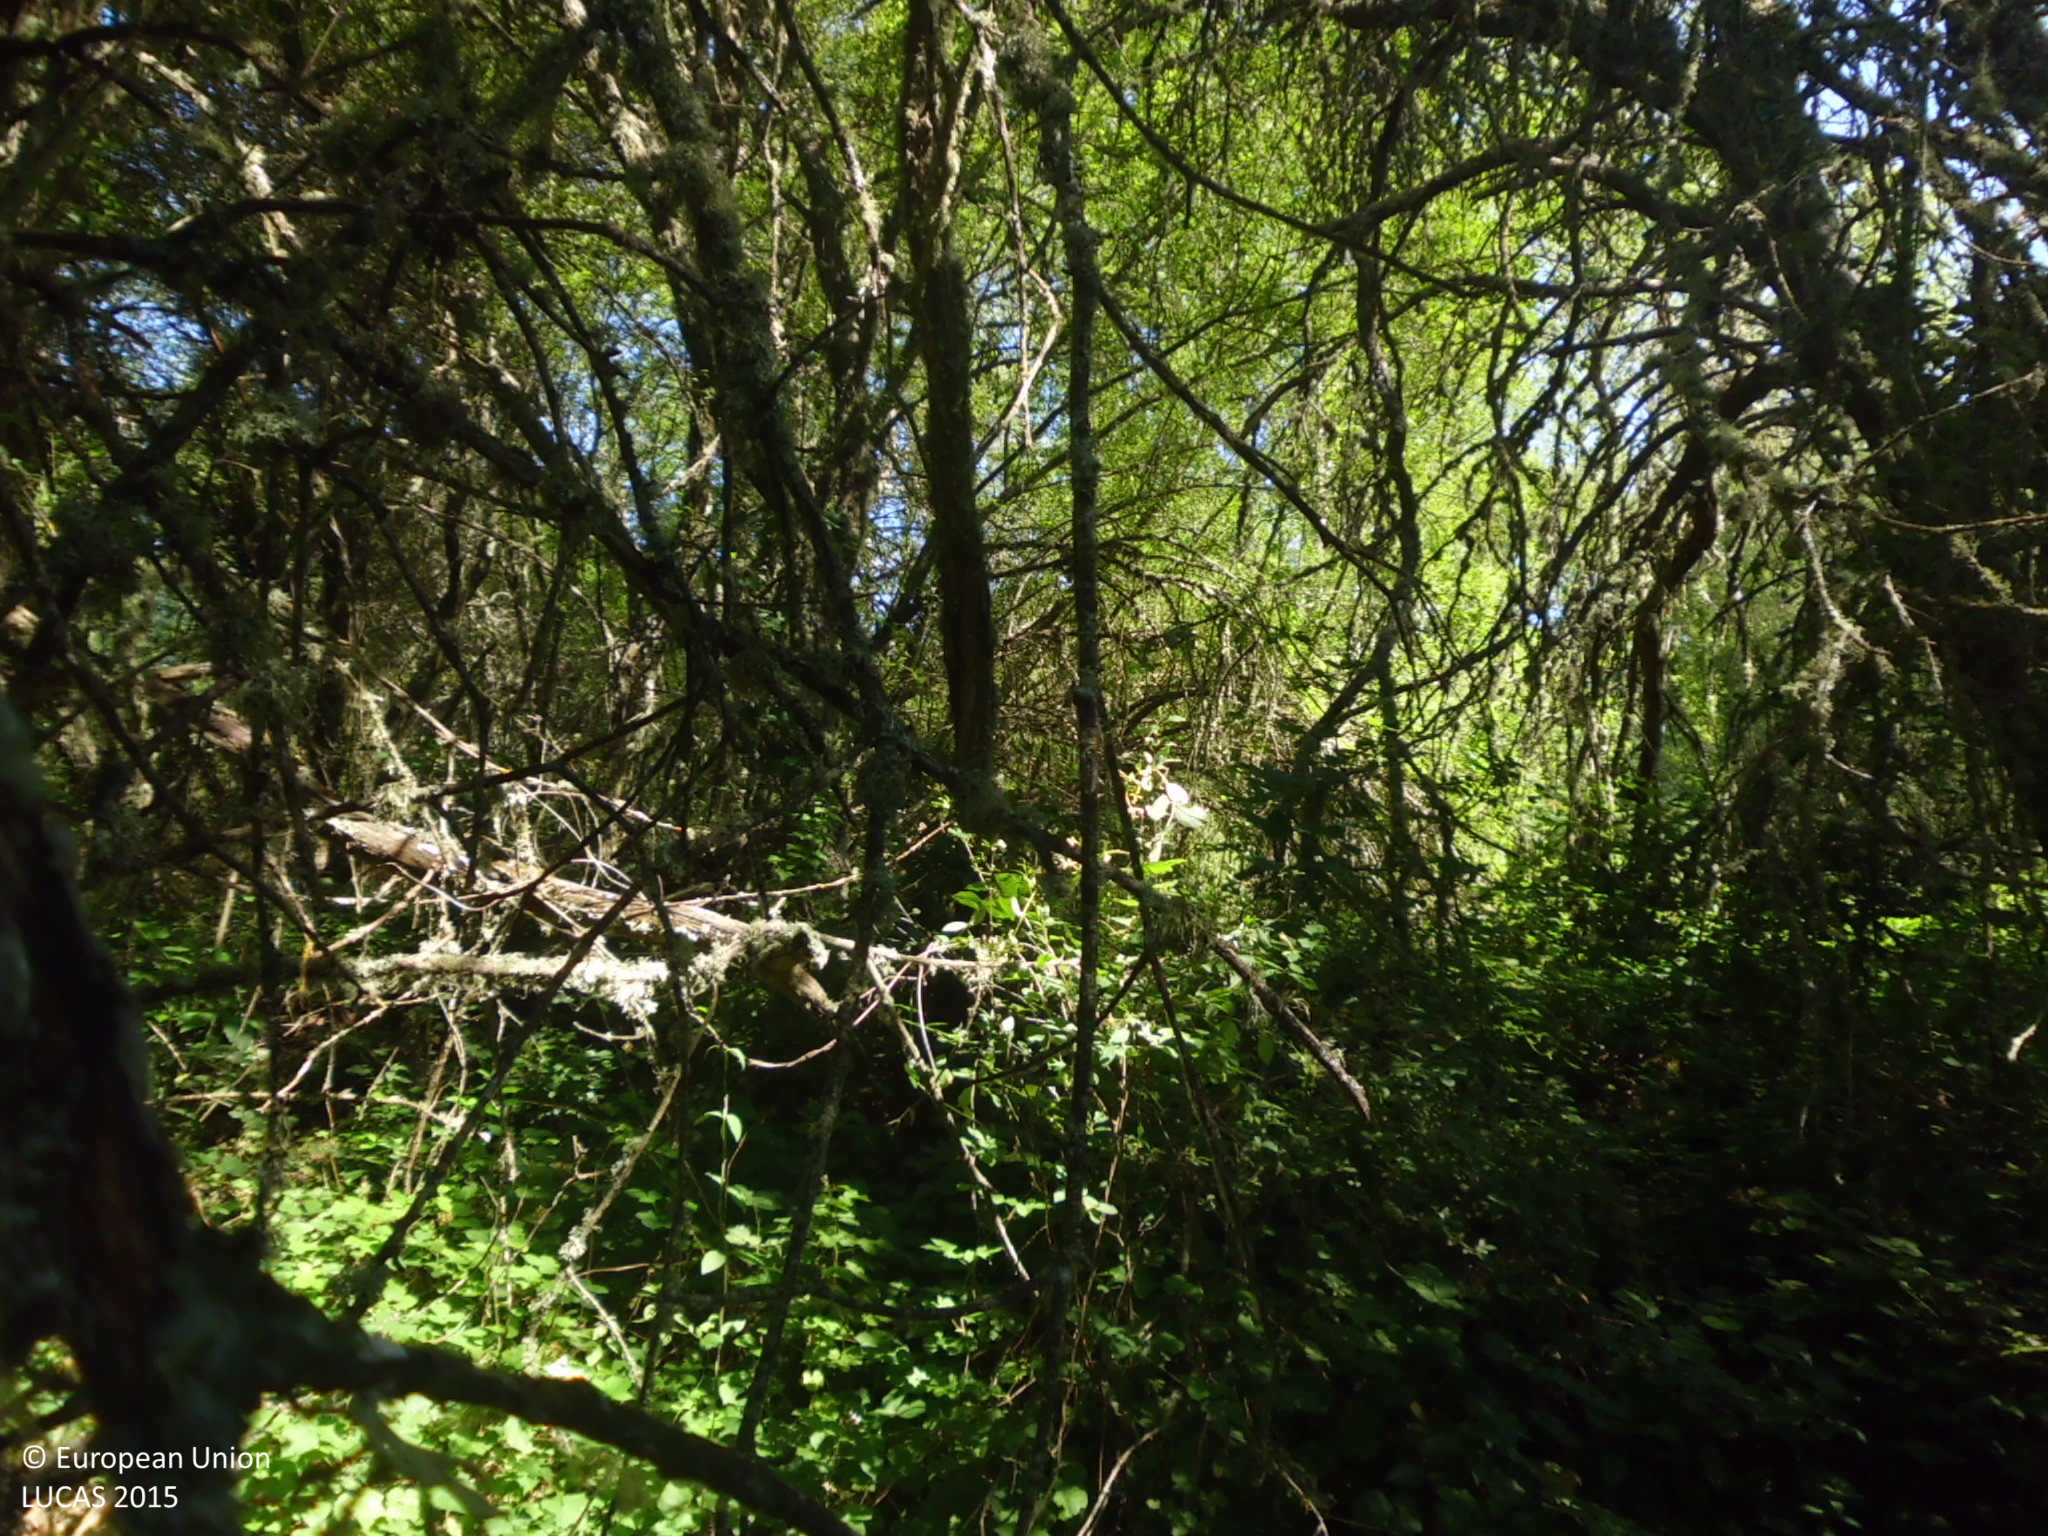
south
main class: Woodland
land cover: Broadleaved woodland
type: acidophilous oak and oak-birch forest
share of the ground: > 75 %
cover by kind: broadleaved forest trees 95 %, shrubs 5 %
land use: Semi-natural and natural areas not in use
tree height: > 5 m
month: July
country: ES
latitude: 42.3091
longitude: -3.3883
